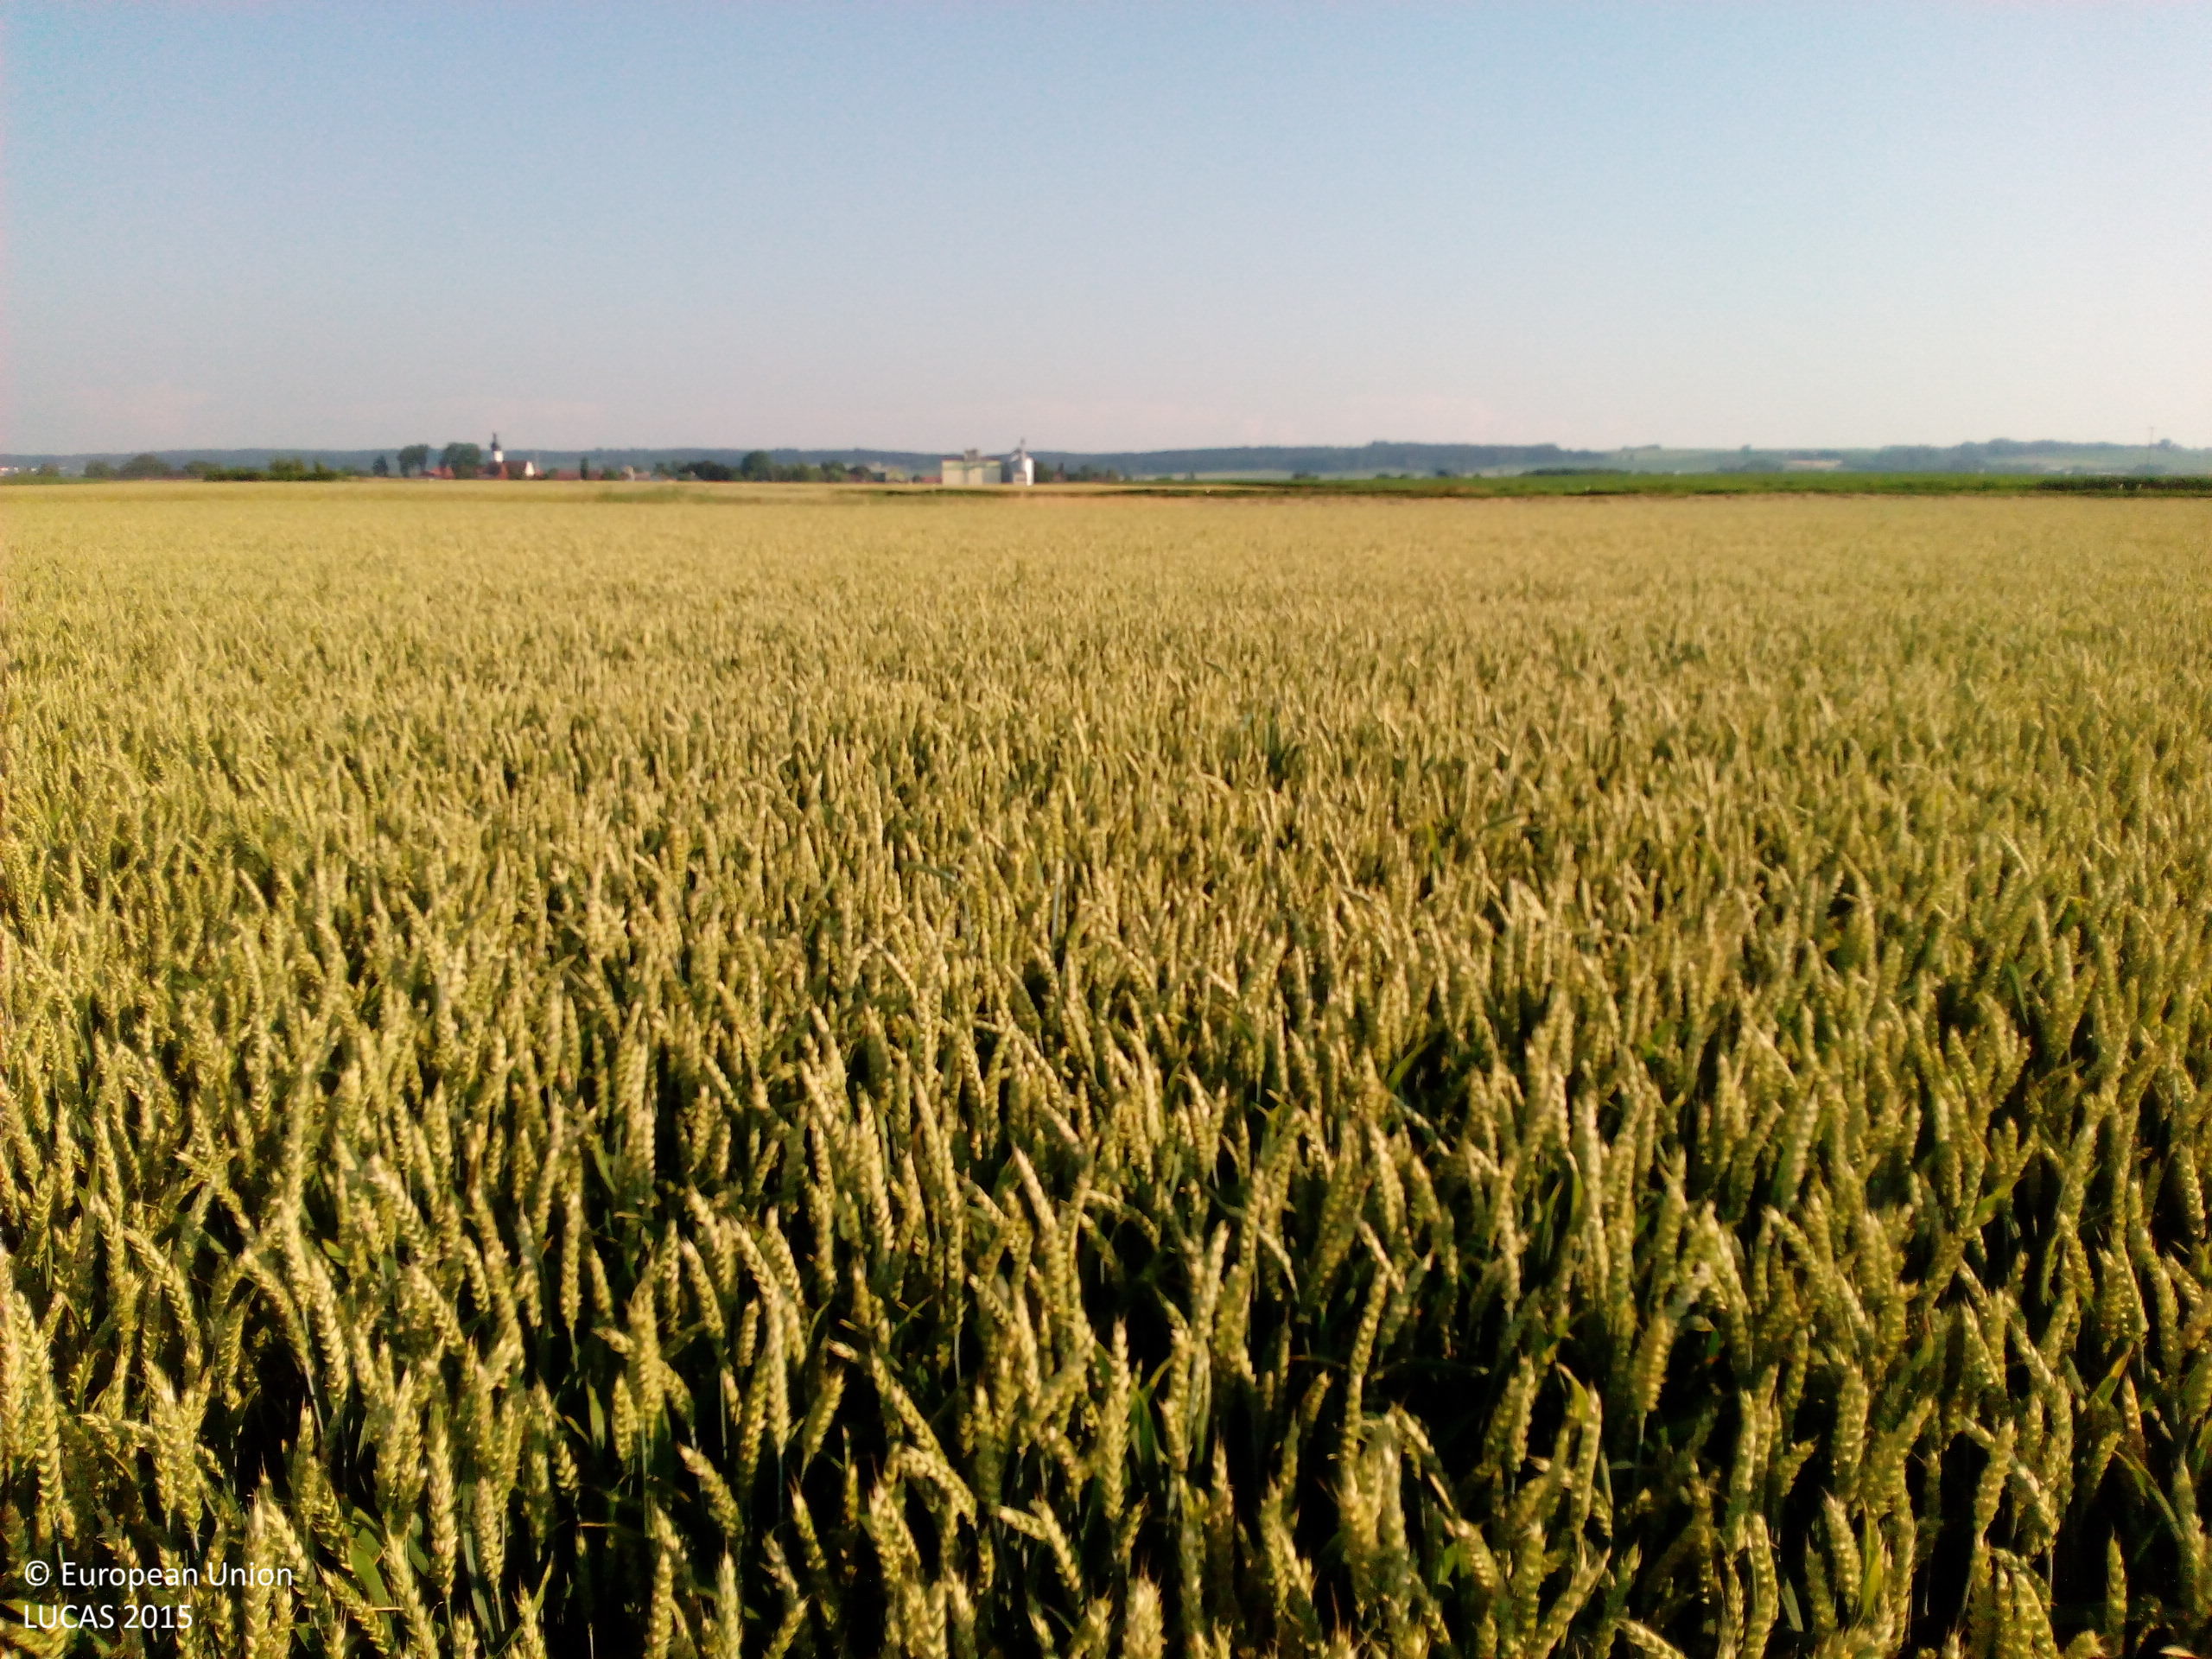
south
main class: Cropland
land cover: Common wheat
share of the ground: > 75 %
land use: Agriculture (excluding fallow land and kitchen gardens)
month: July
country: DE
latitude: 48.7070
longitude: 12.9210
